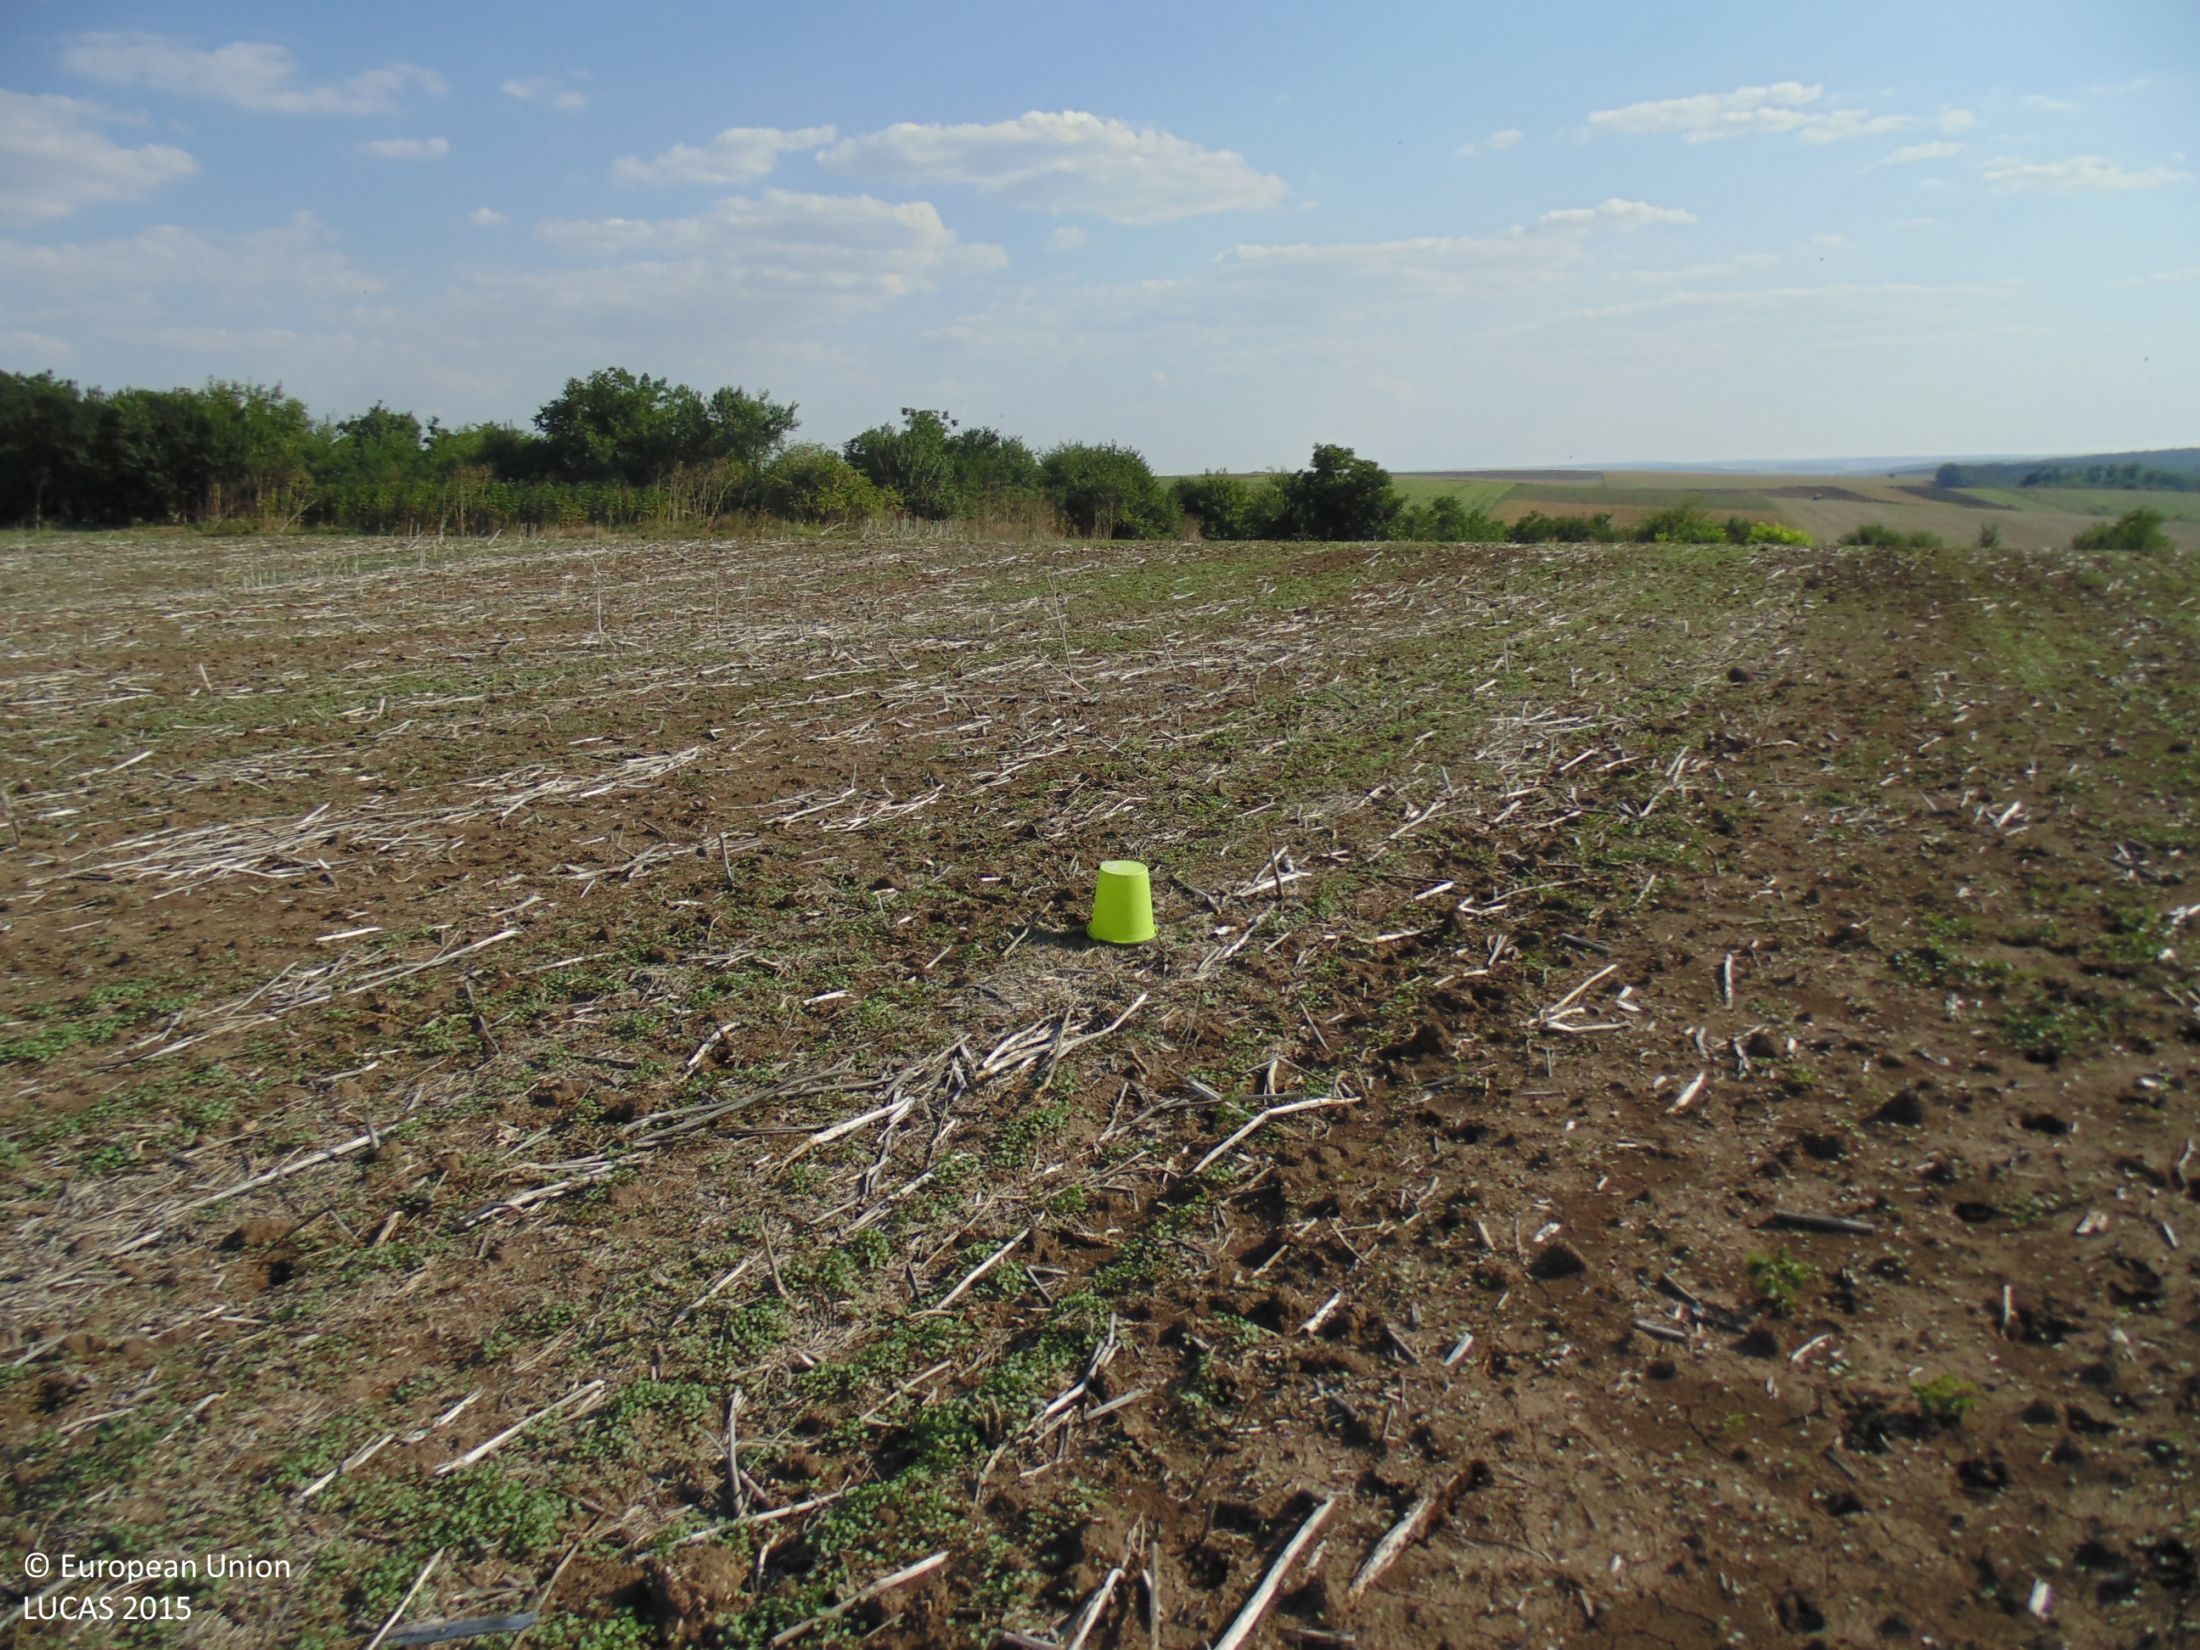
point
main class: Cropland
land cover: Rape and turnip rape
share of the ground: < 10 %
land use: Agriculture (excluding fallow land and kitchen gardens)
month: August
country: BG
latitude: 43.7262
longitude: 27.2200
